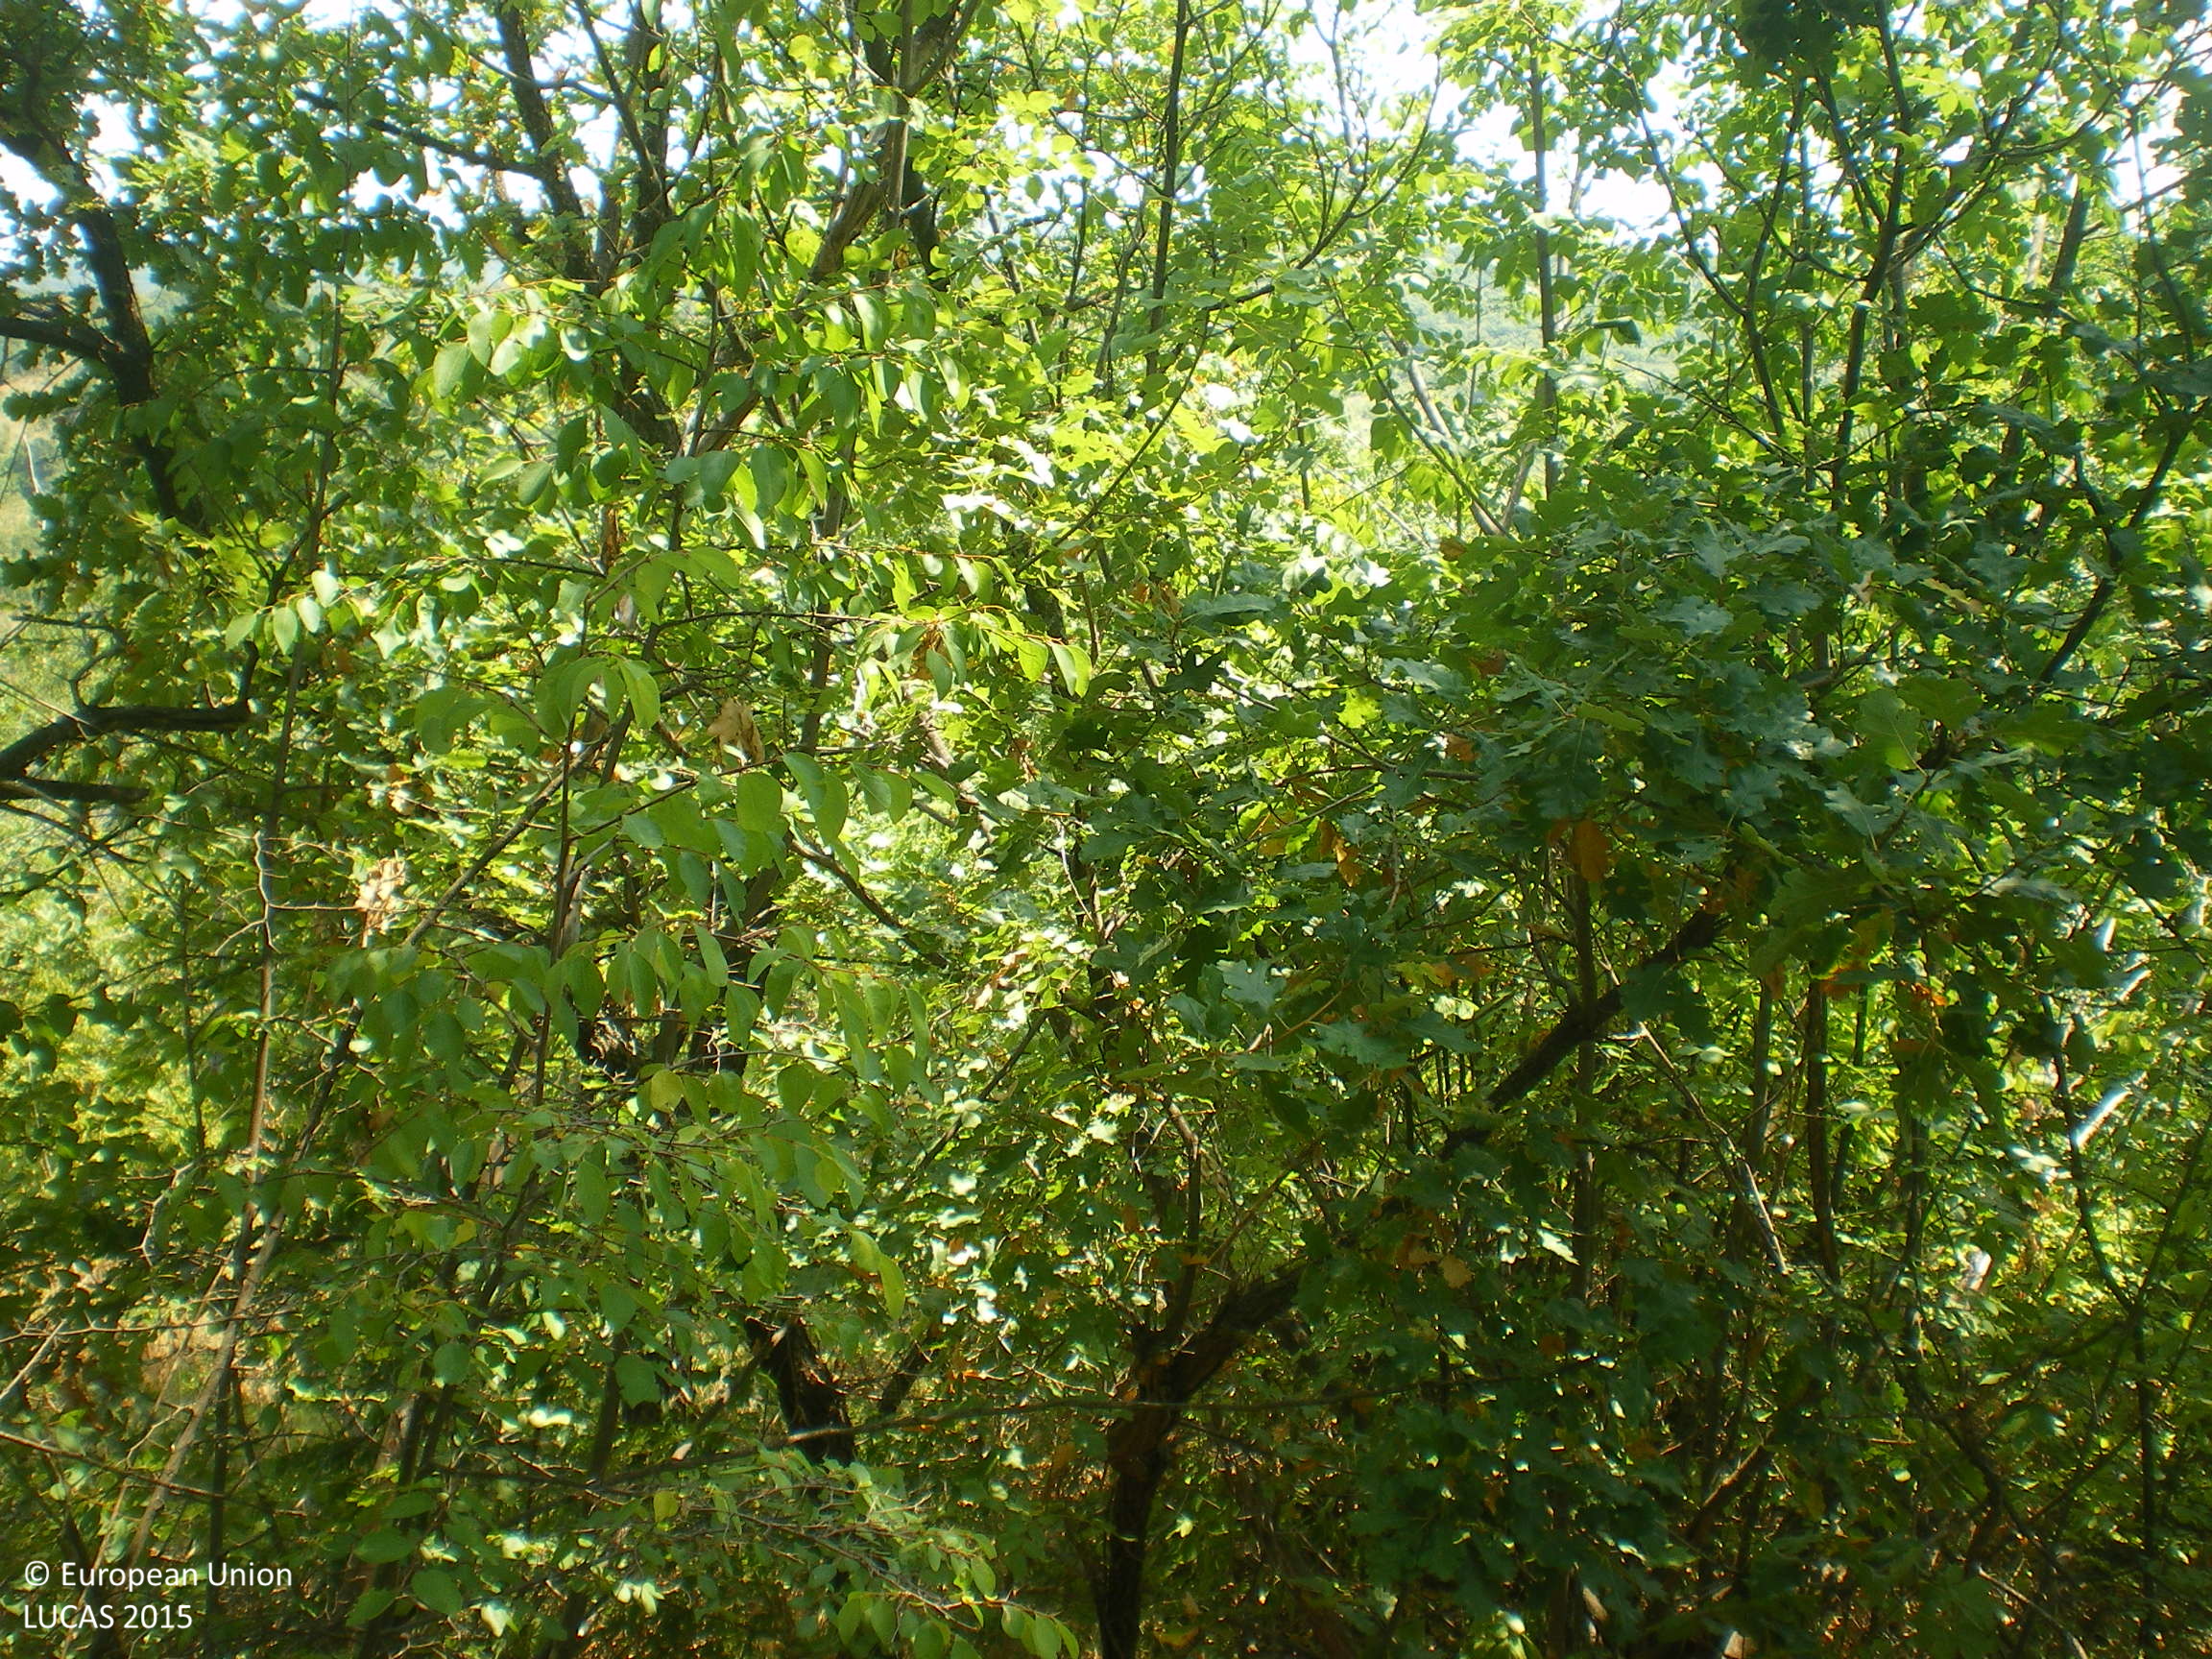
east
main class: Woodland
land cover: Broadleaved woodland
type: mesophytic deciduous forest
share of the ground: > 75 %
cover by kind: broadleaved forest trees 95 %, unconsolidated bare surface 5 %
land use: Forestry
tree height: > 5 m
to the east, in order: Broadleaved woodland; Pine dominated coniferous woodland; Tracks; Pine dominated coniferous woodland
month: August
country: BG
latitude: 42.3771
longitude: 25.4551
